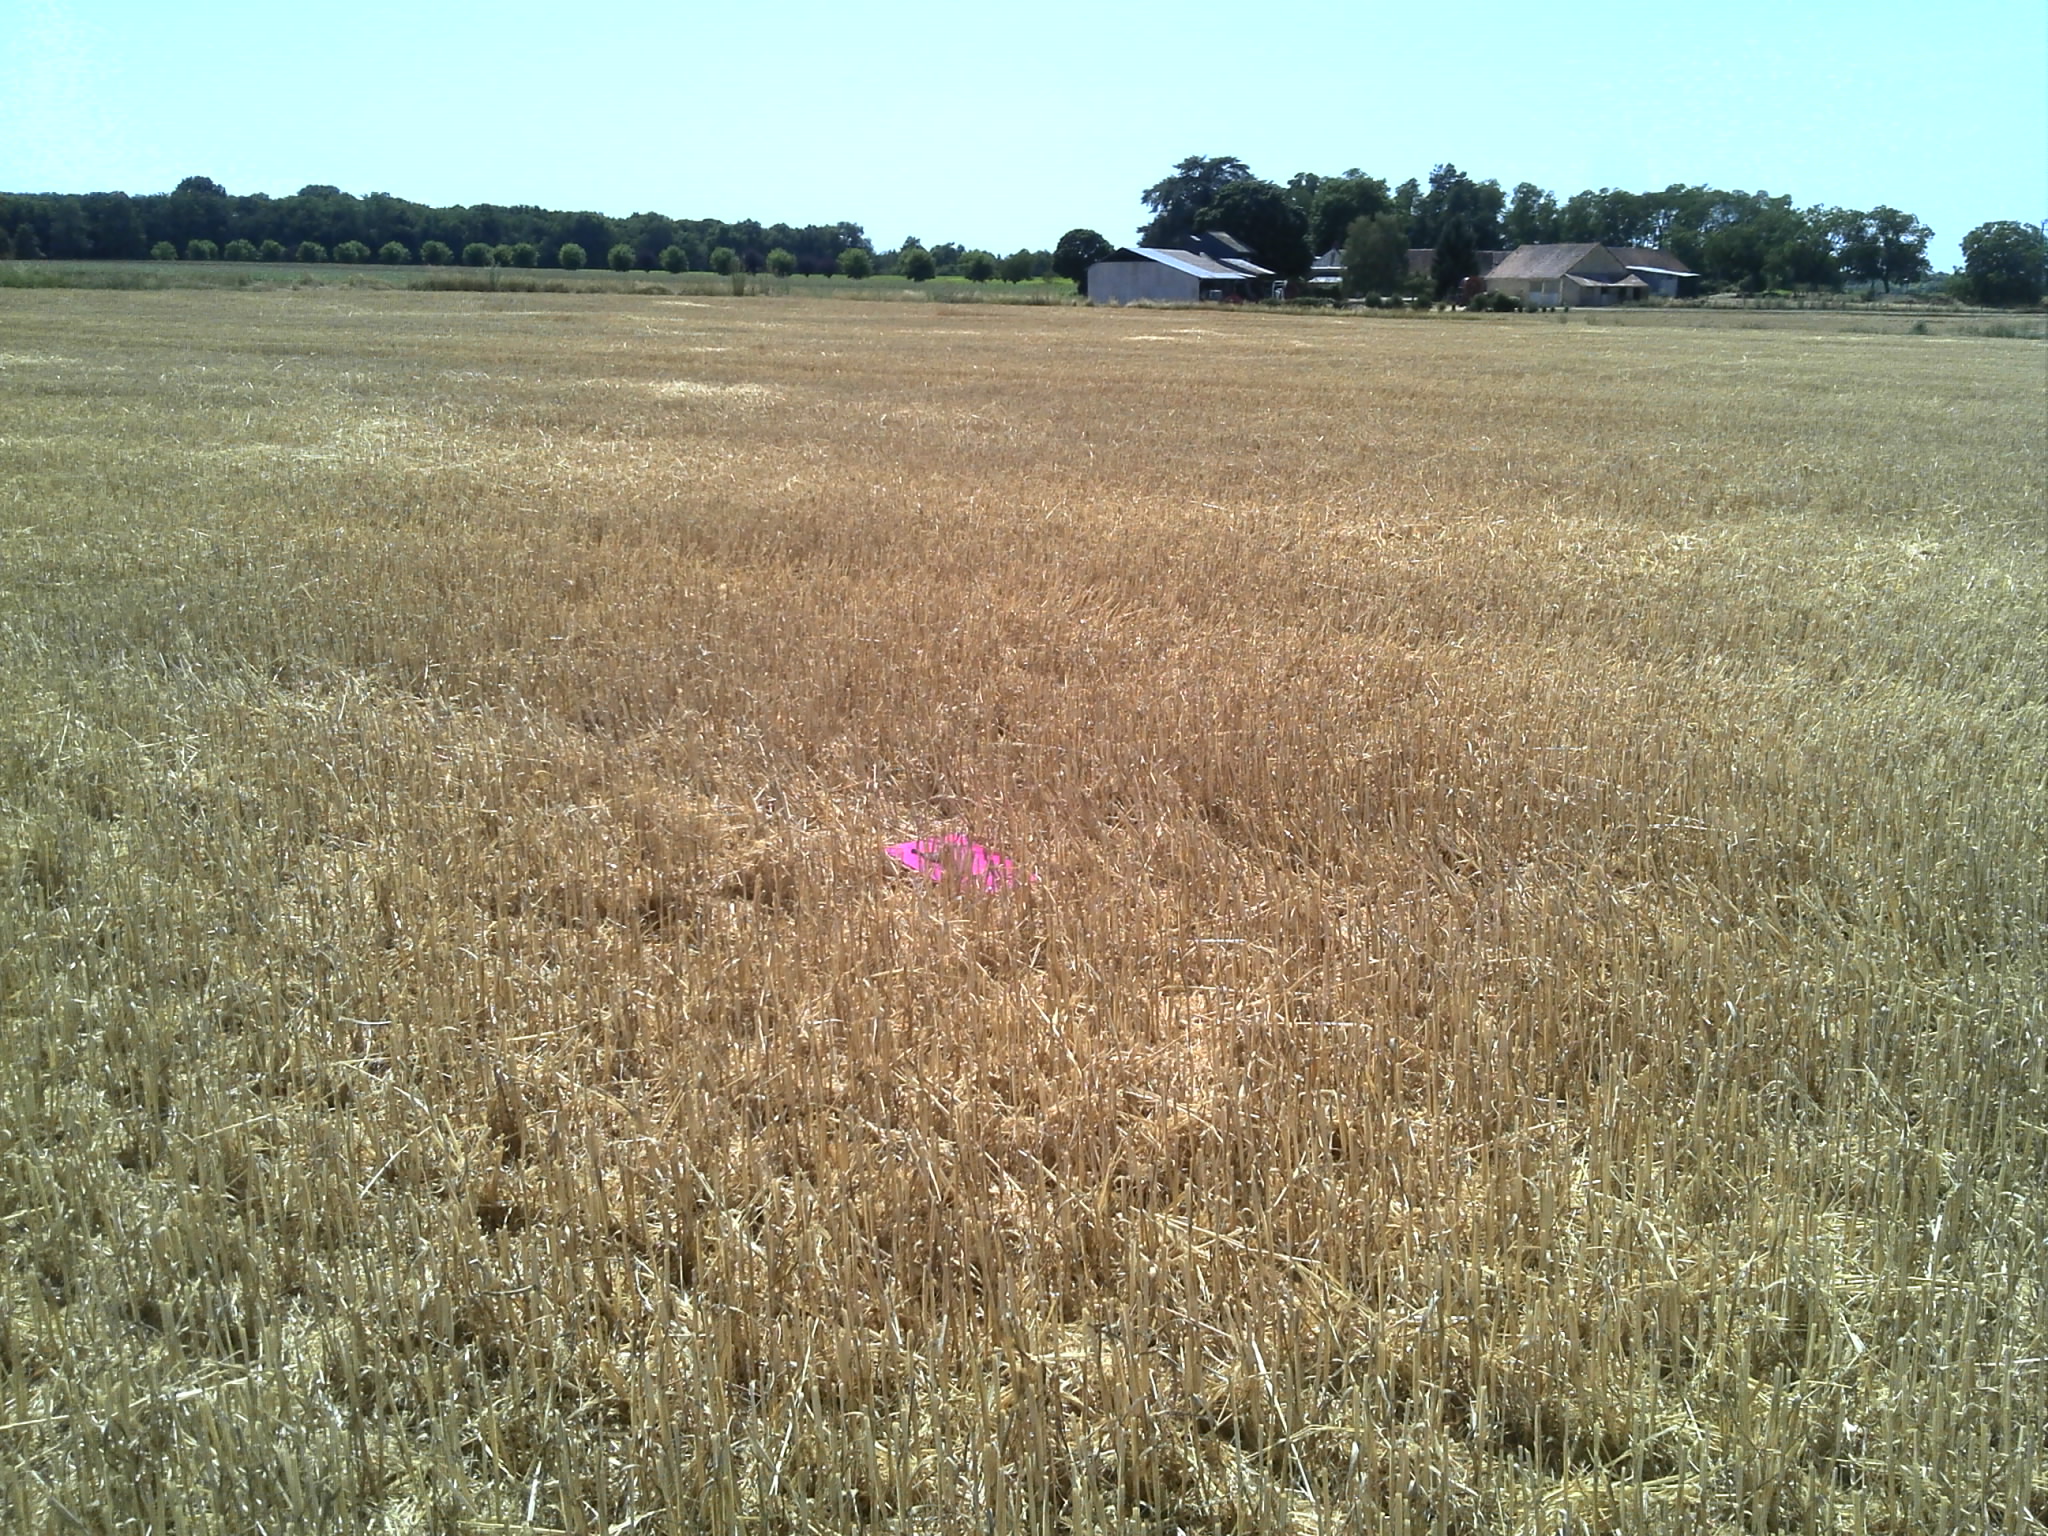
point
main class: Cropland
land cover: Durum wheat
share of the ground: 50 - 75 %
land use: Agriculture (excluding fallow land and kitchen gardens)
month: July
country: FR
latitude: 46.8792
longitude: 1.4722
